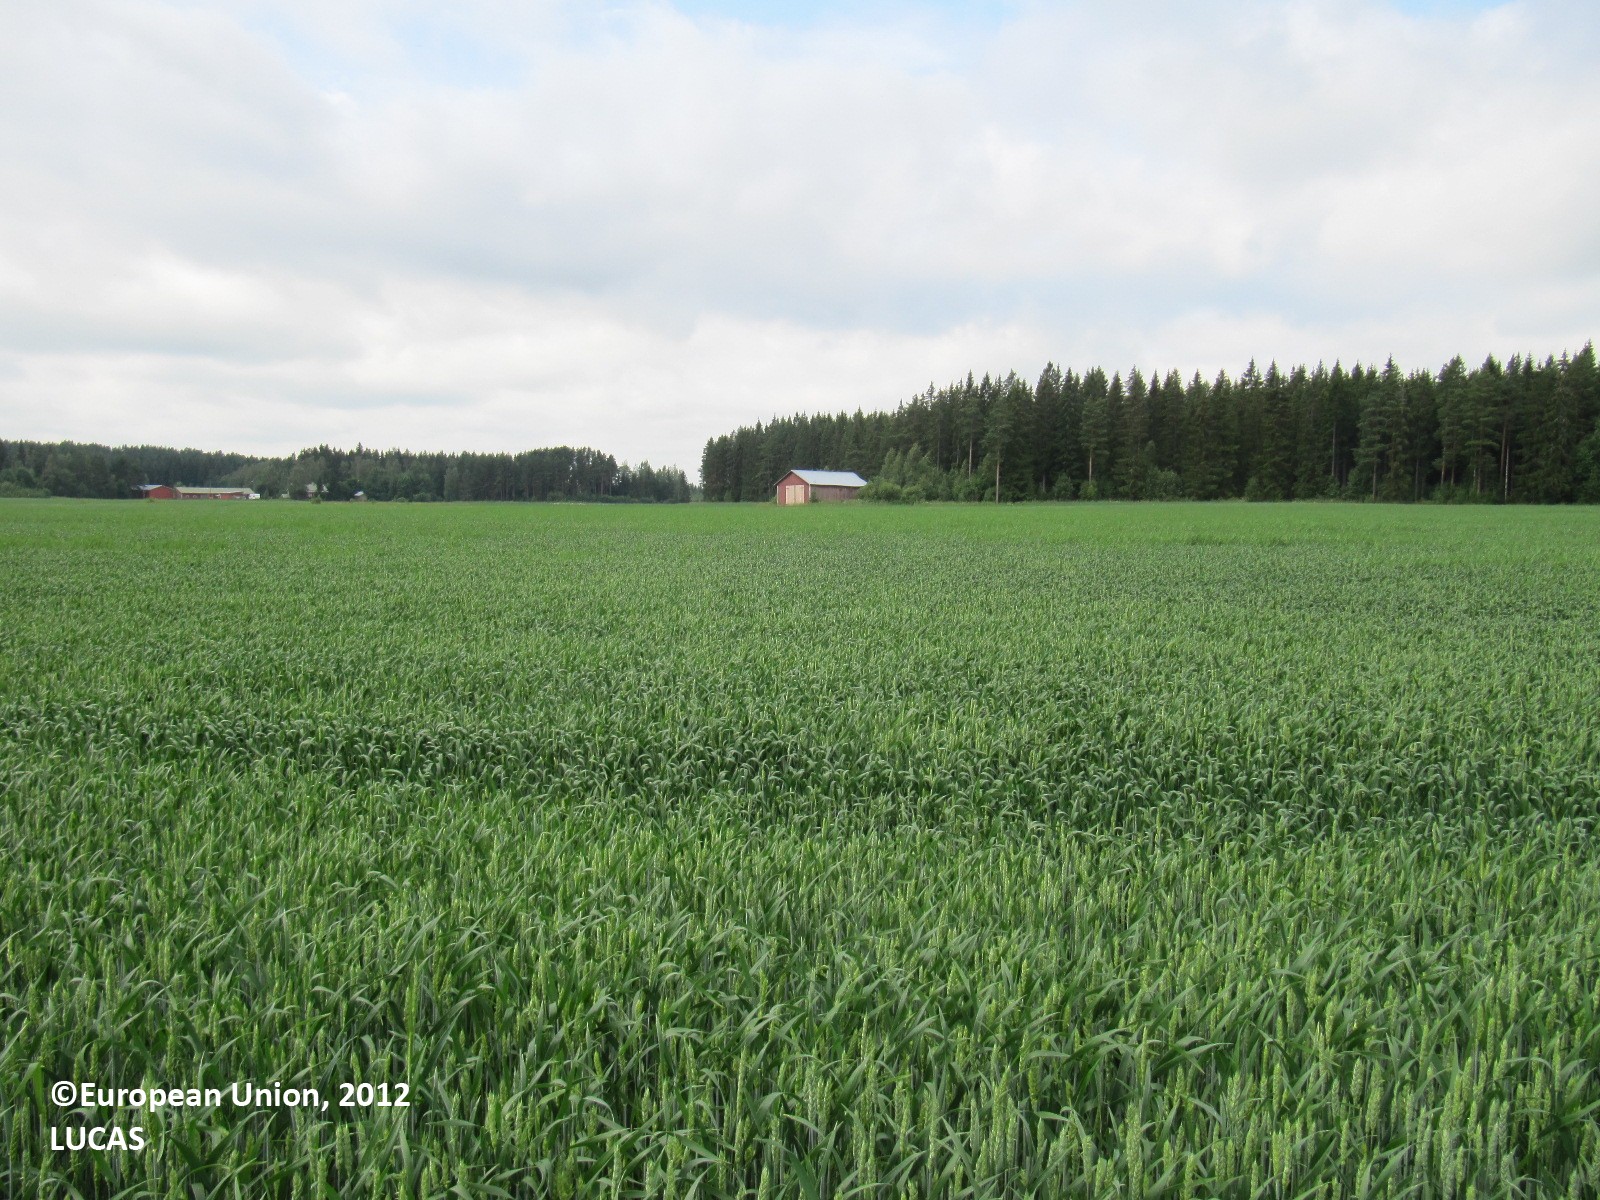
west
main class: Cropland
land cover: Common wheat
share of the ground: > 75 %
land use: Agriculture (excluding fallow land and kitchen gardens)
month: July
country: FI
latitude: 60.8277
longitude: 23.3044
